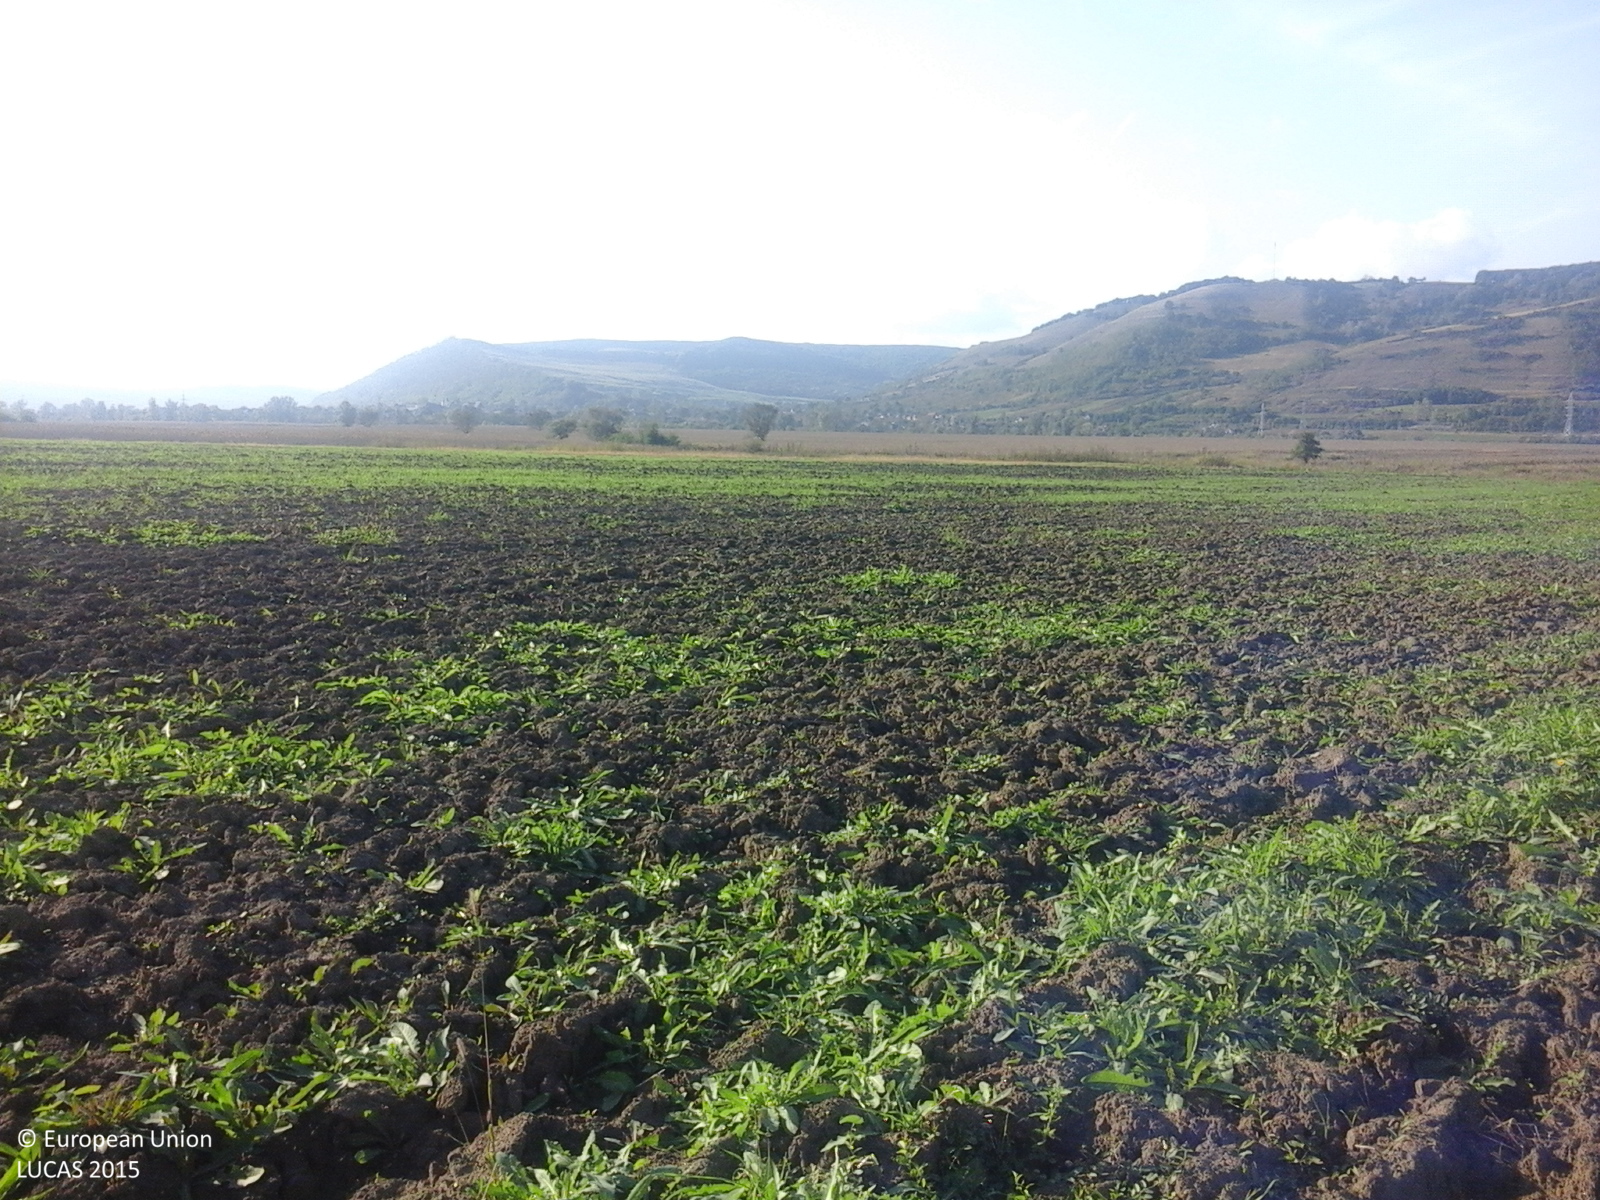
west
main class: Grassland
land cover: Spontaneously vegetated surfaces
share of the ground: > 75 %
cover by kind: herbaceous plants 100 %
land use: Agriculture (excluding fallow land and kitchen gardens)
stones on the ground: < 10 %
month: October
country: RO
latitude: 46.0831
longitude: 24.1335
